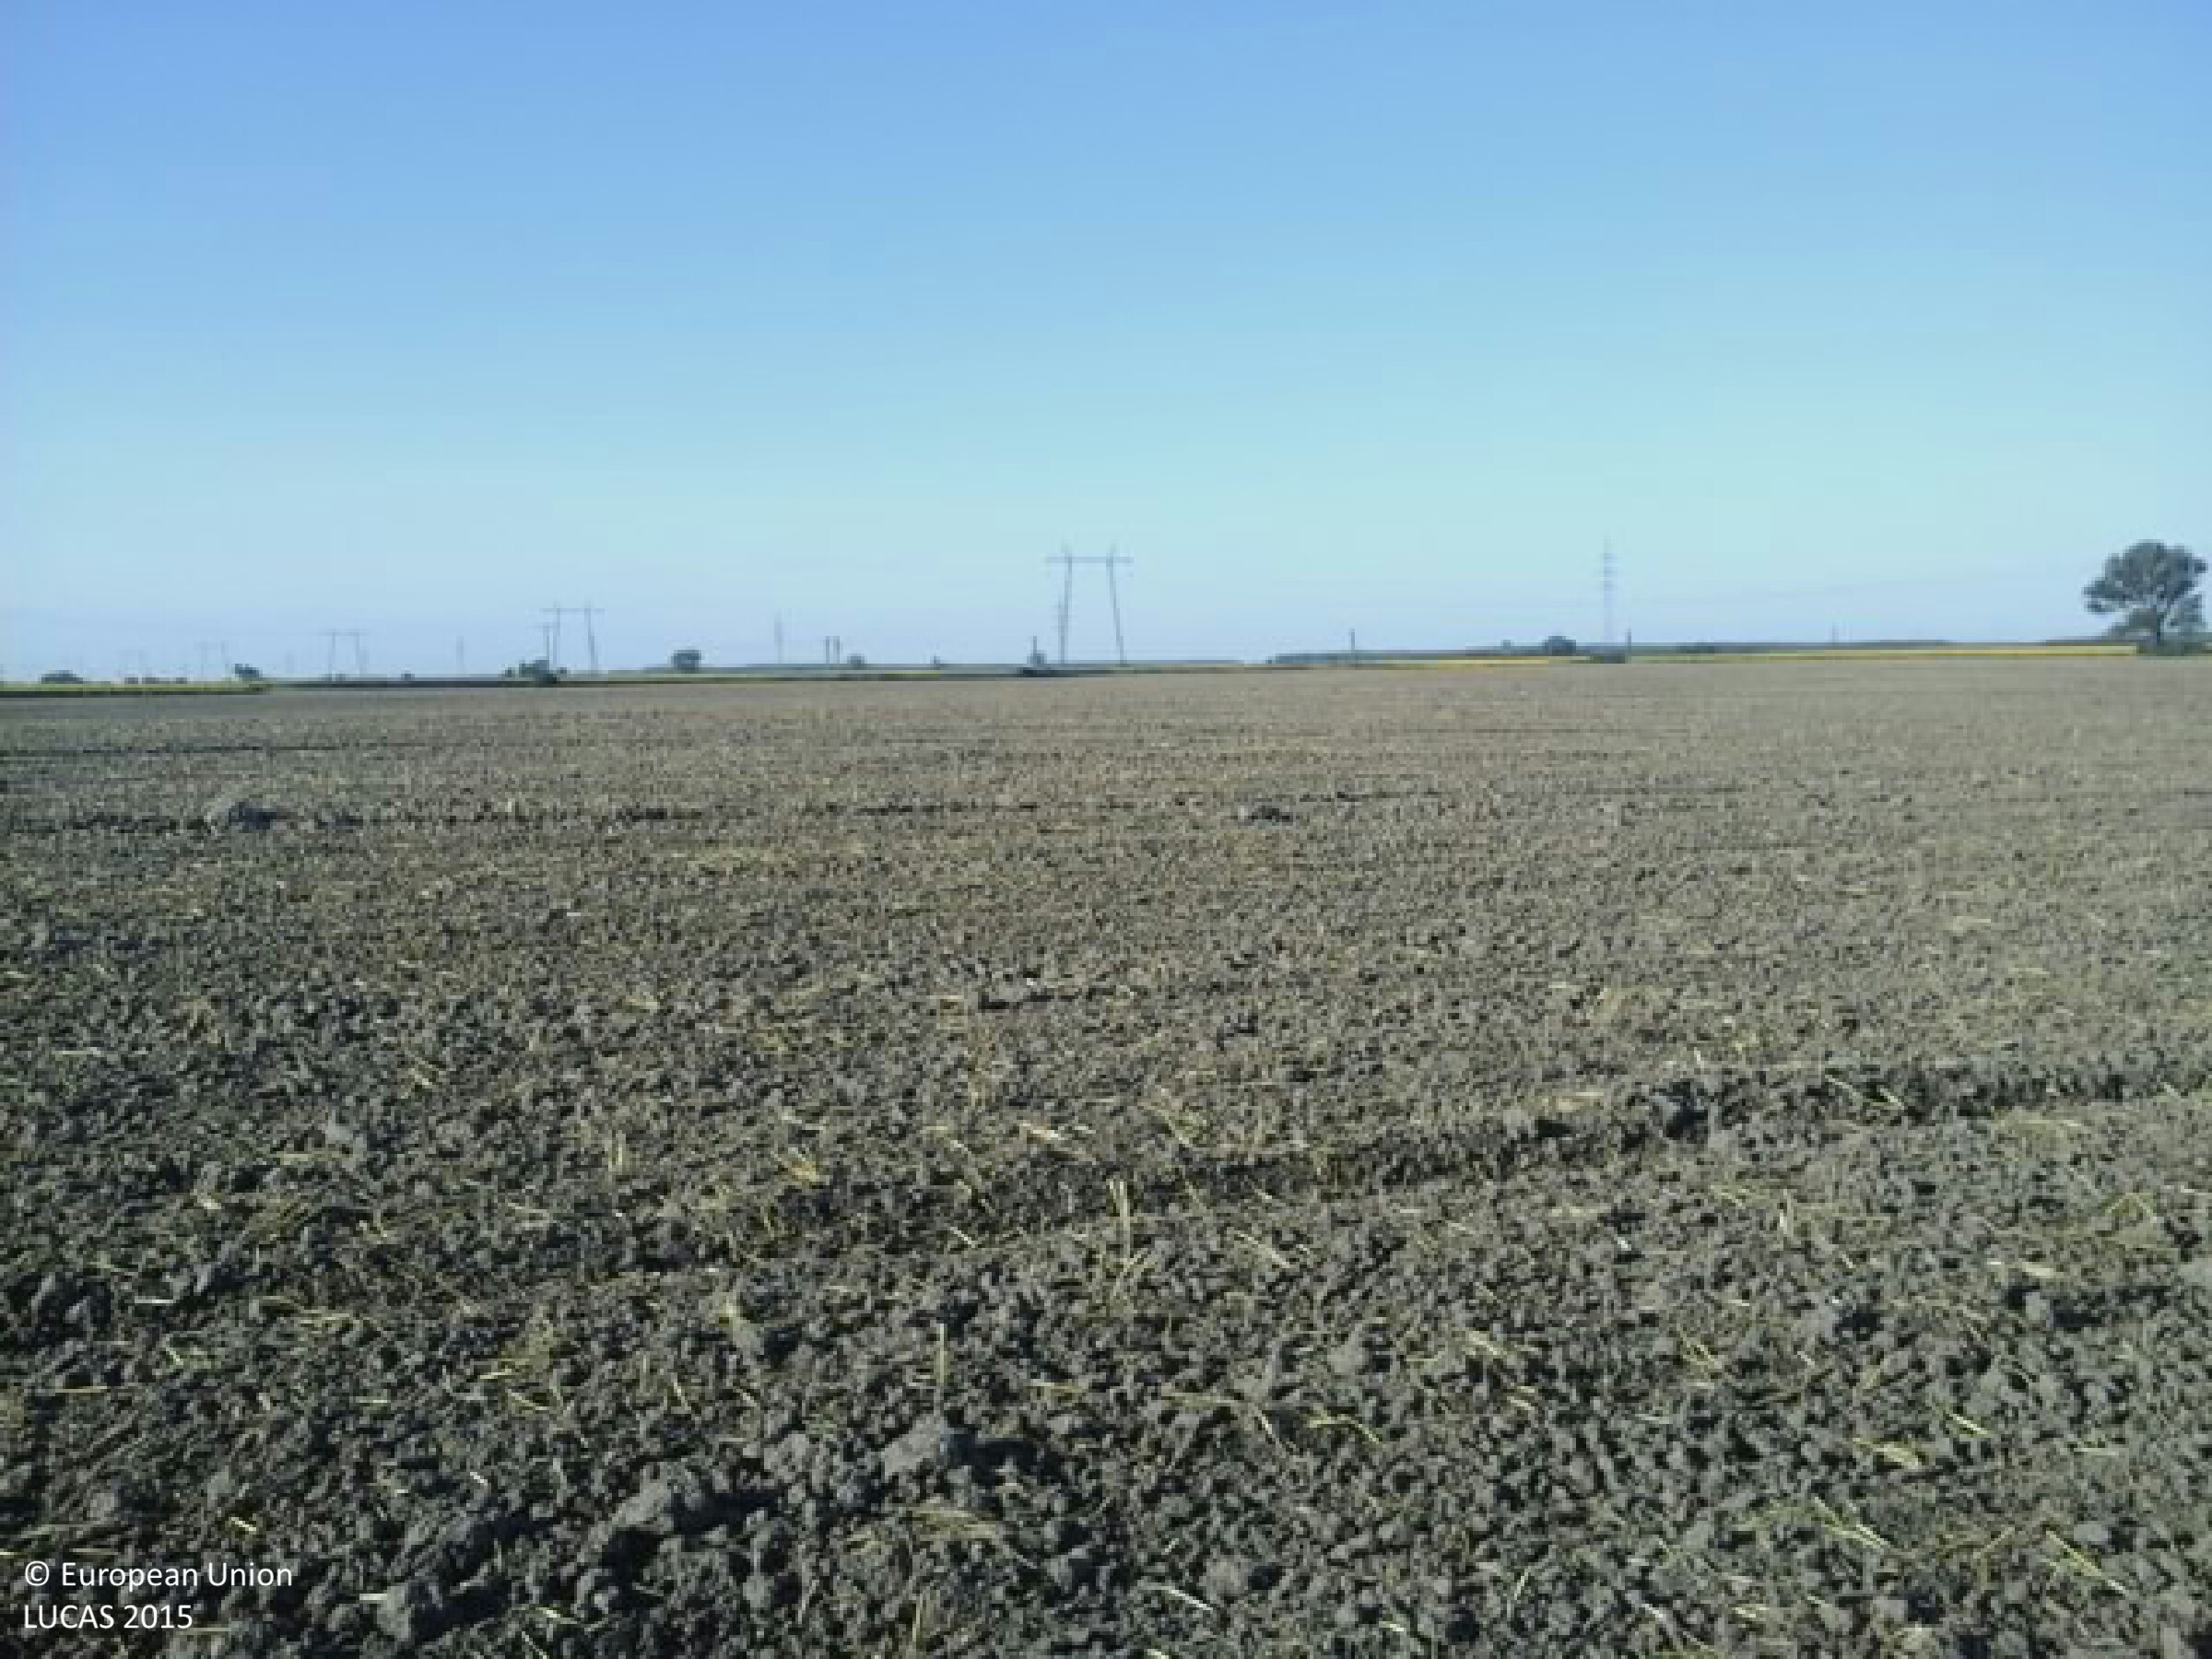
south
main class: Cropland
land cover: Common wheat
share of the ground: < 10 %
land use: Agriculture (excluding fallow land and kitchen gardens)
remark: Harvested field
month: July
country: HU
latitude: 46.5438
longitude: 18.8675
